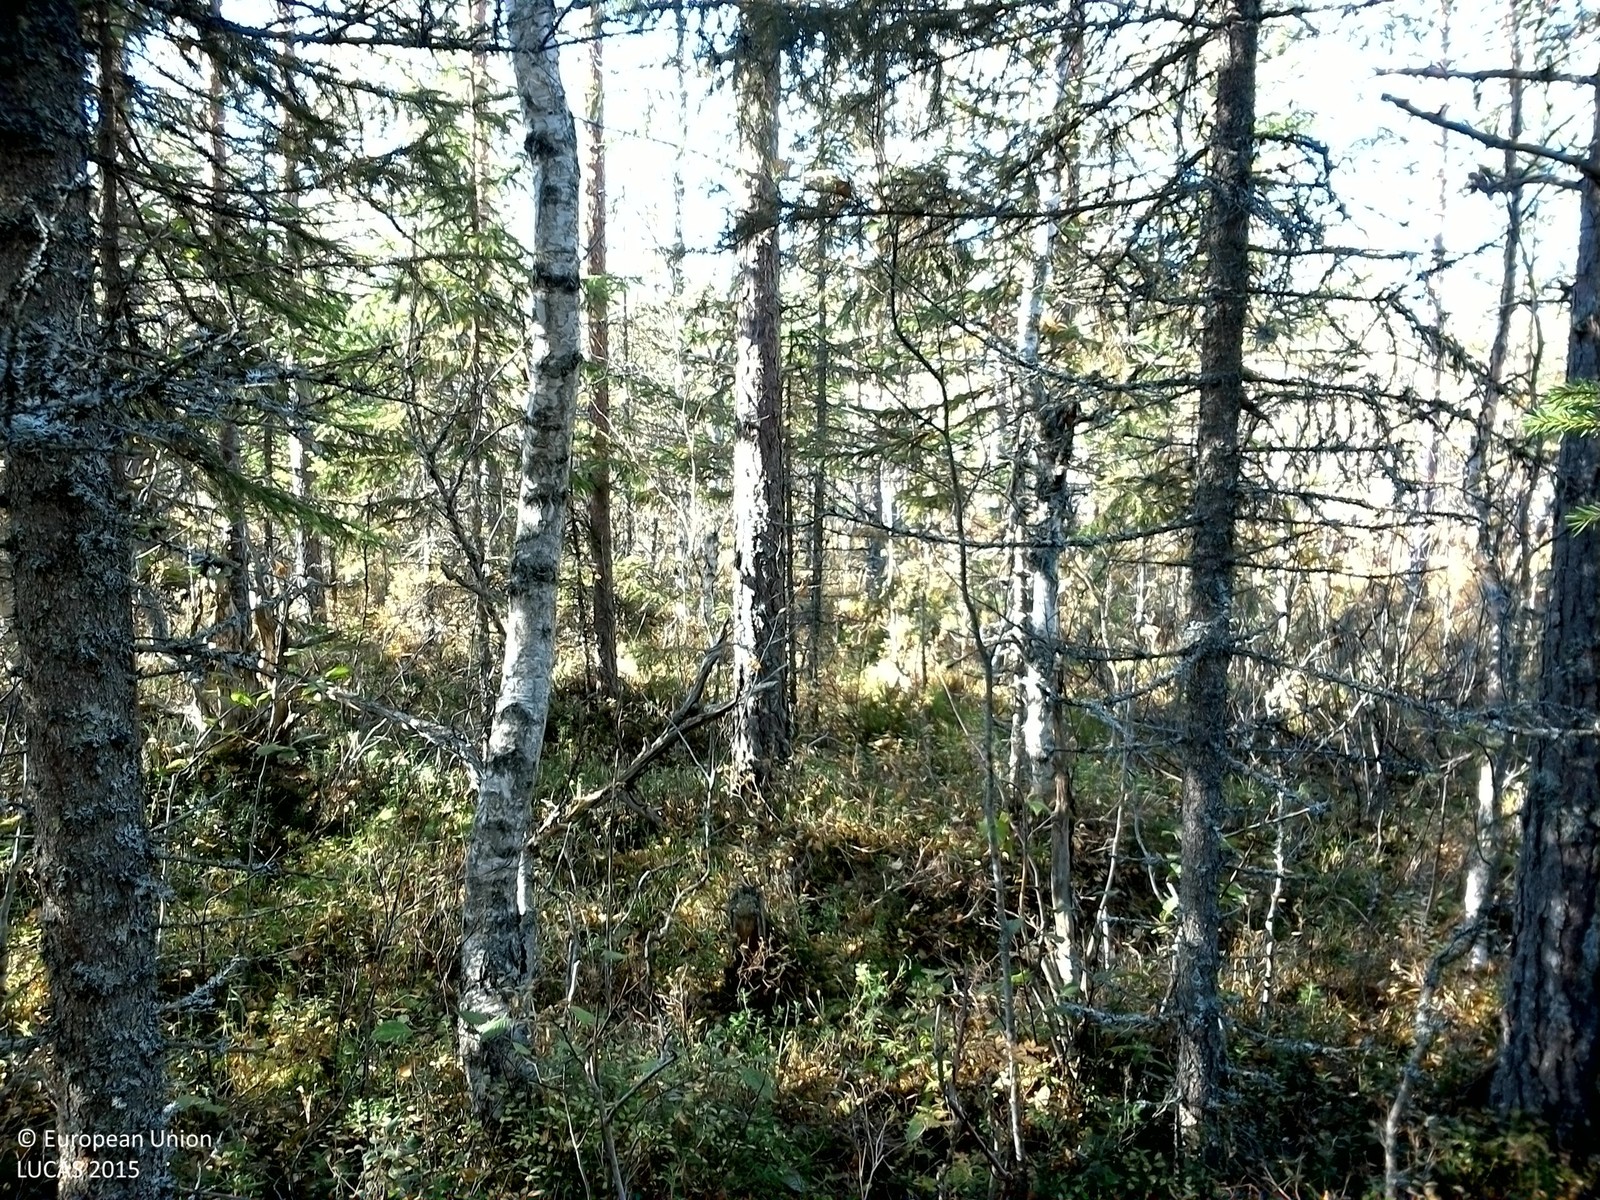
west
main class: Woodland
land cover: Other mixed woodland
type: boreal forest
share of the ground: 50 - 75 %
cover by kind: coniferous forest trees 50 %, broadleaved forest trees 20 %, shrubs 20 %, lichens and mosses 10 %
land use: Forestry
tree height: > 5 m
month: October
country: SE
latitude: 61.3728
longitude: 15.0179
